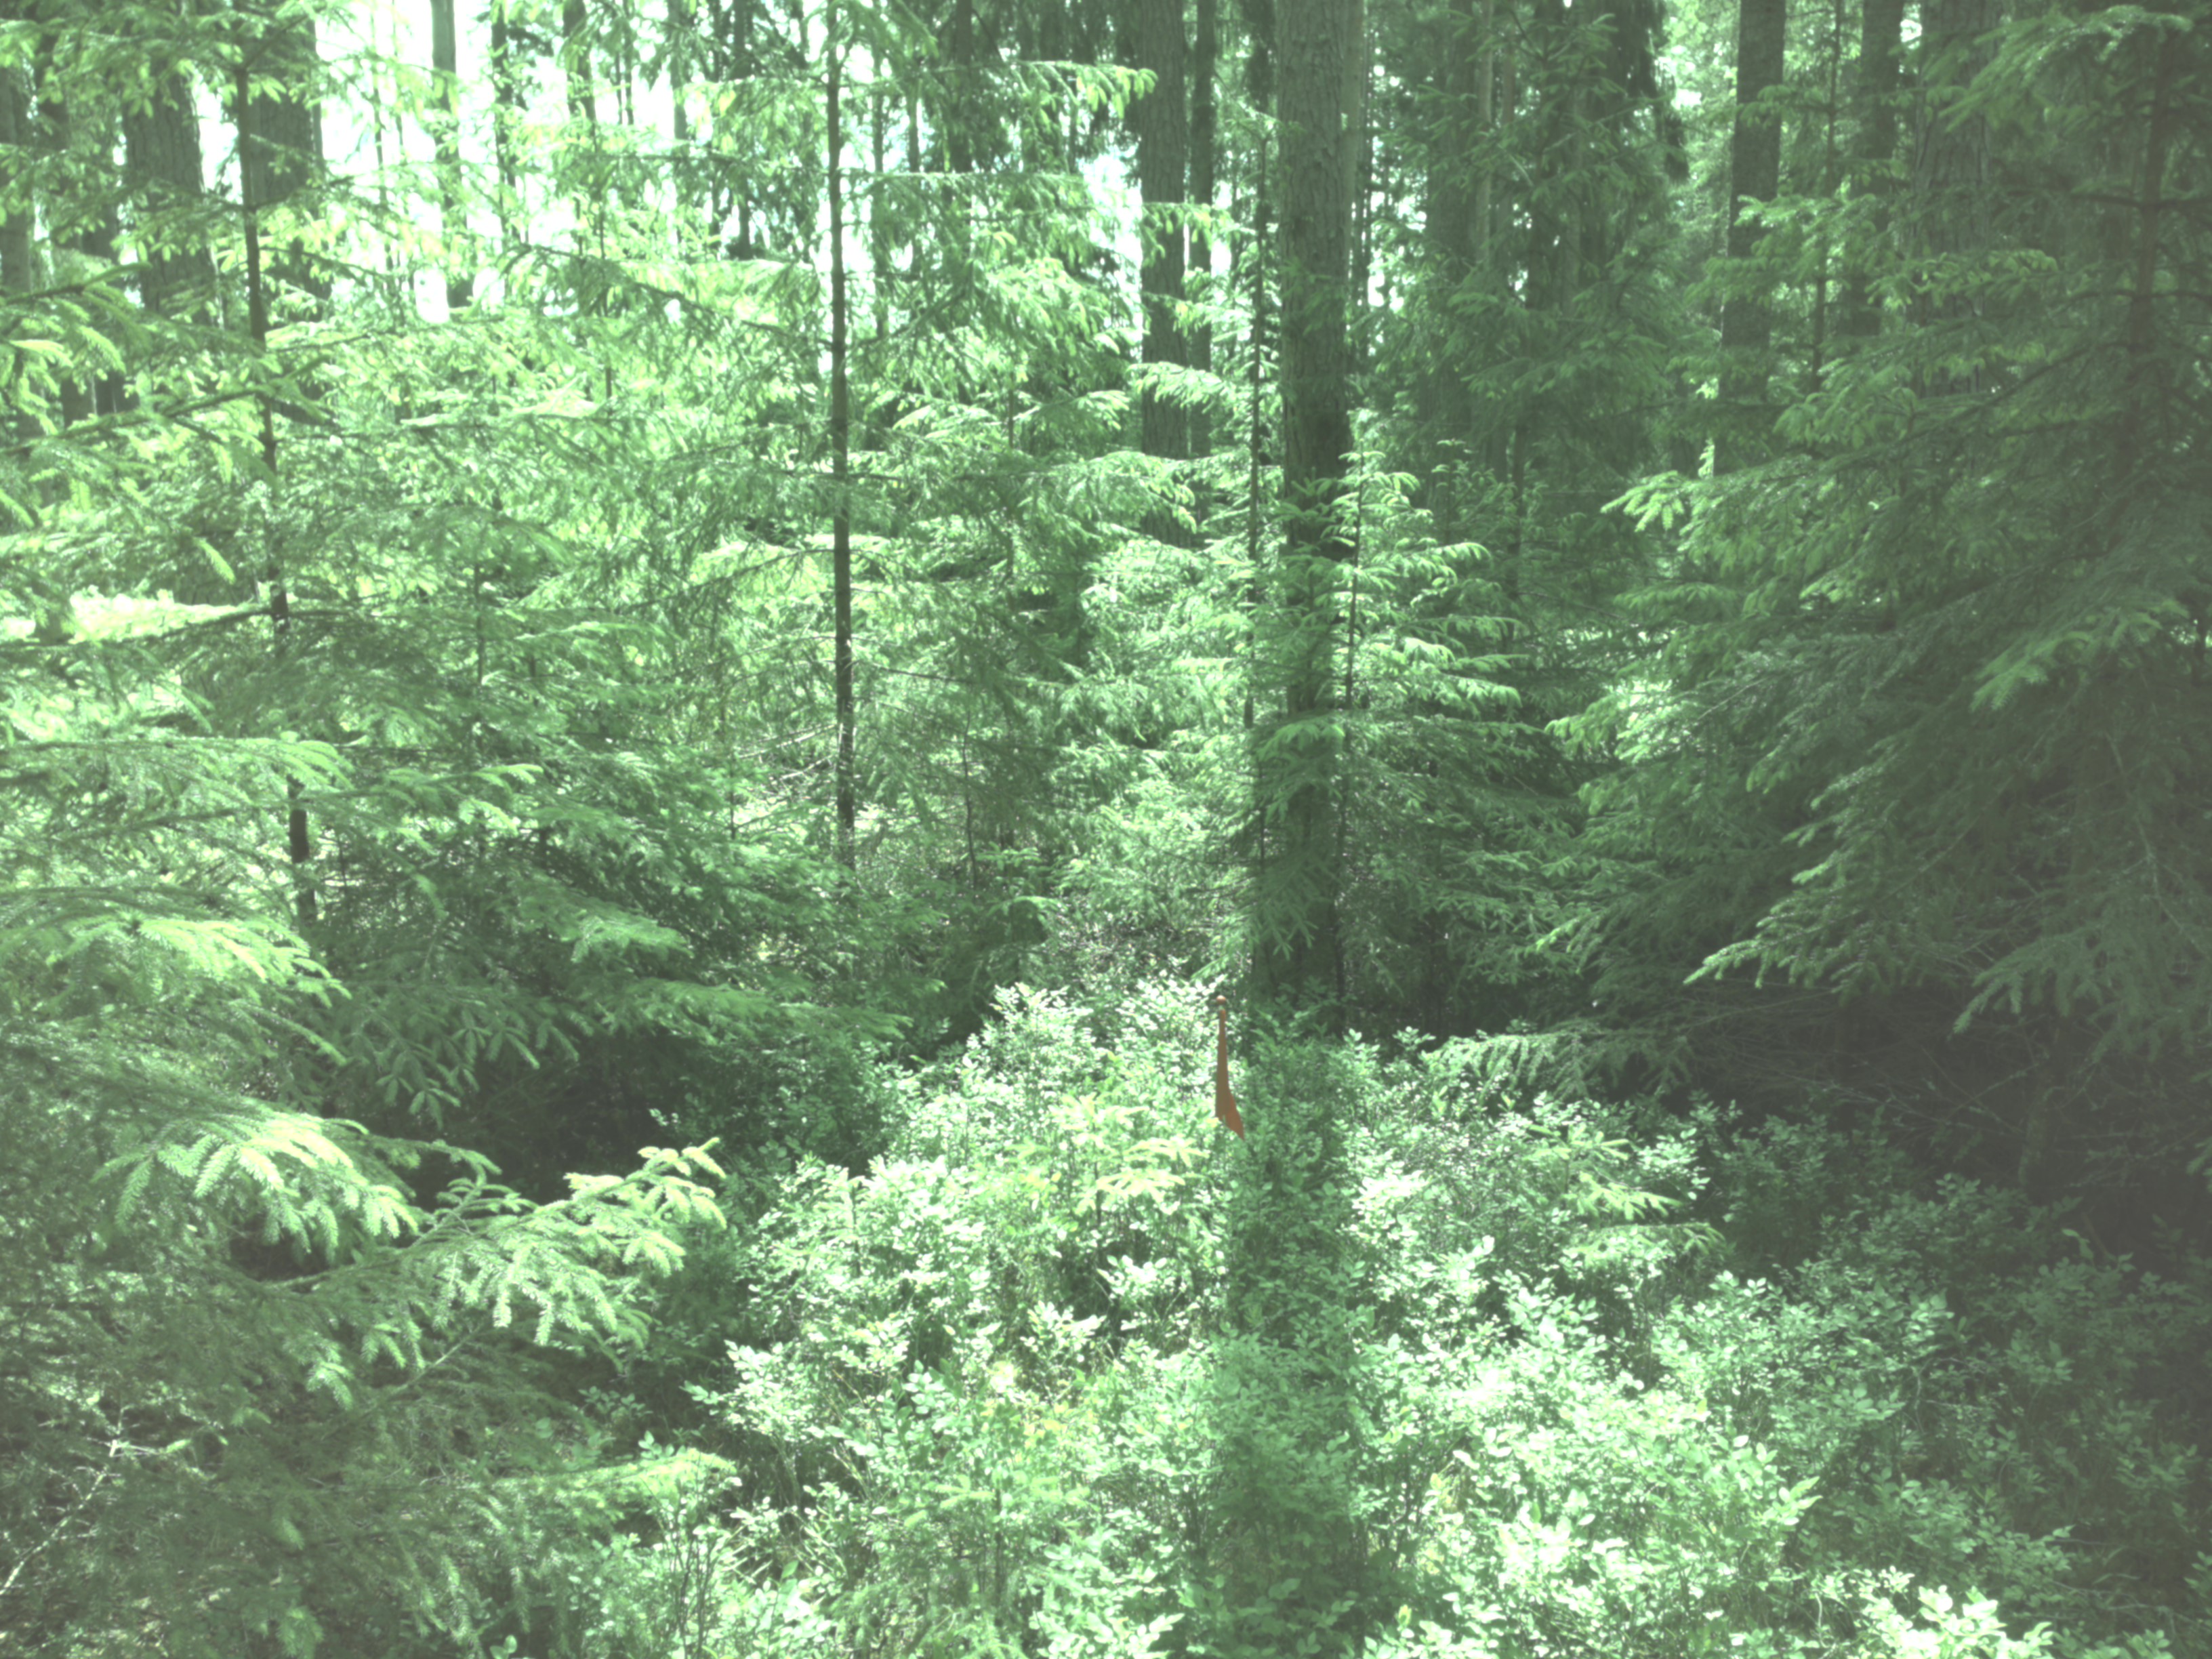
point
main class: Woodland
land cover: Pine dominated coniferous woodland
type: boreal forest
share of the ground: 50 - 75 %
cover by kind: coniferous forest trees 70 %, shrubs 20 %, lichens and mosses 10 %
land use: Forestry
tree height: > 5 m
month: June
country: SE
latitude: 59.2187
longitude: 17.5474
